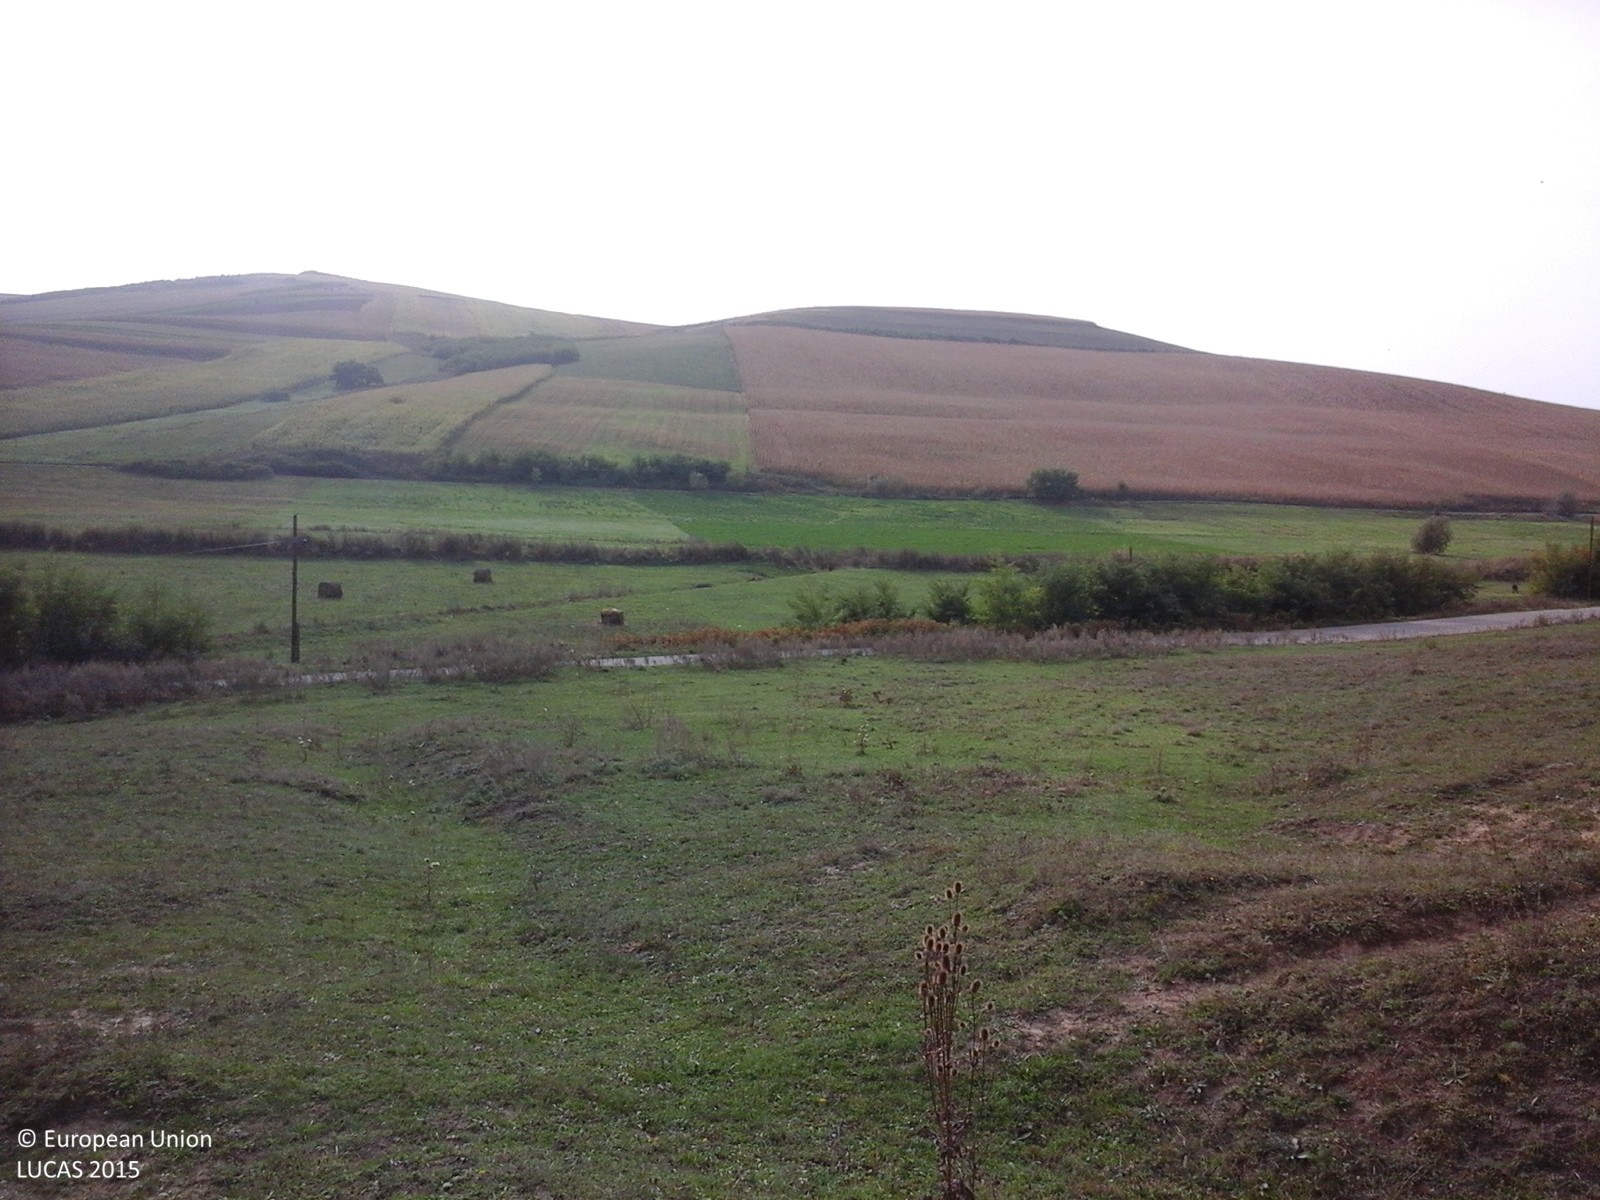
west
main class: Grassland
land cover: Grassland without tree/shrub cover
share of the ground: > 75 %
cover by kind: herbaceous plants 100 %
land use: Agriculture (excluding fallow land and kitchen gardens)
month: September
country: RO
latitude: 46.8126
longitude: 24.1439
